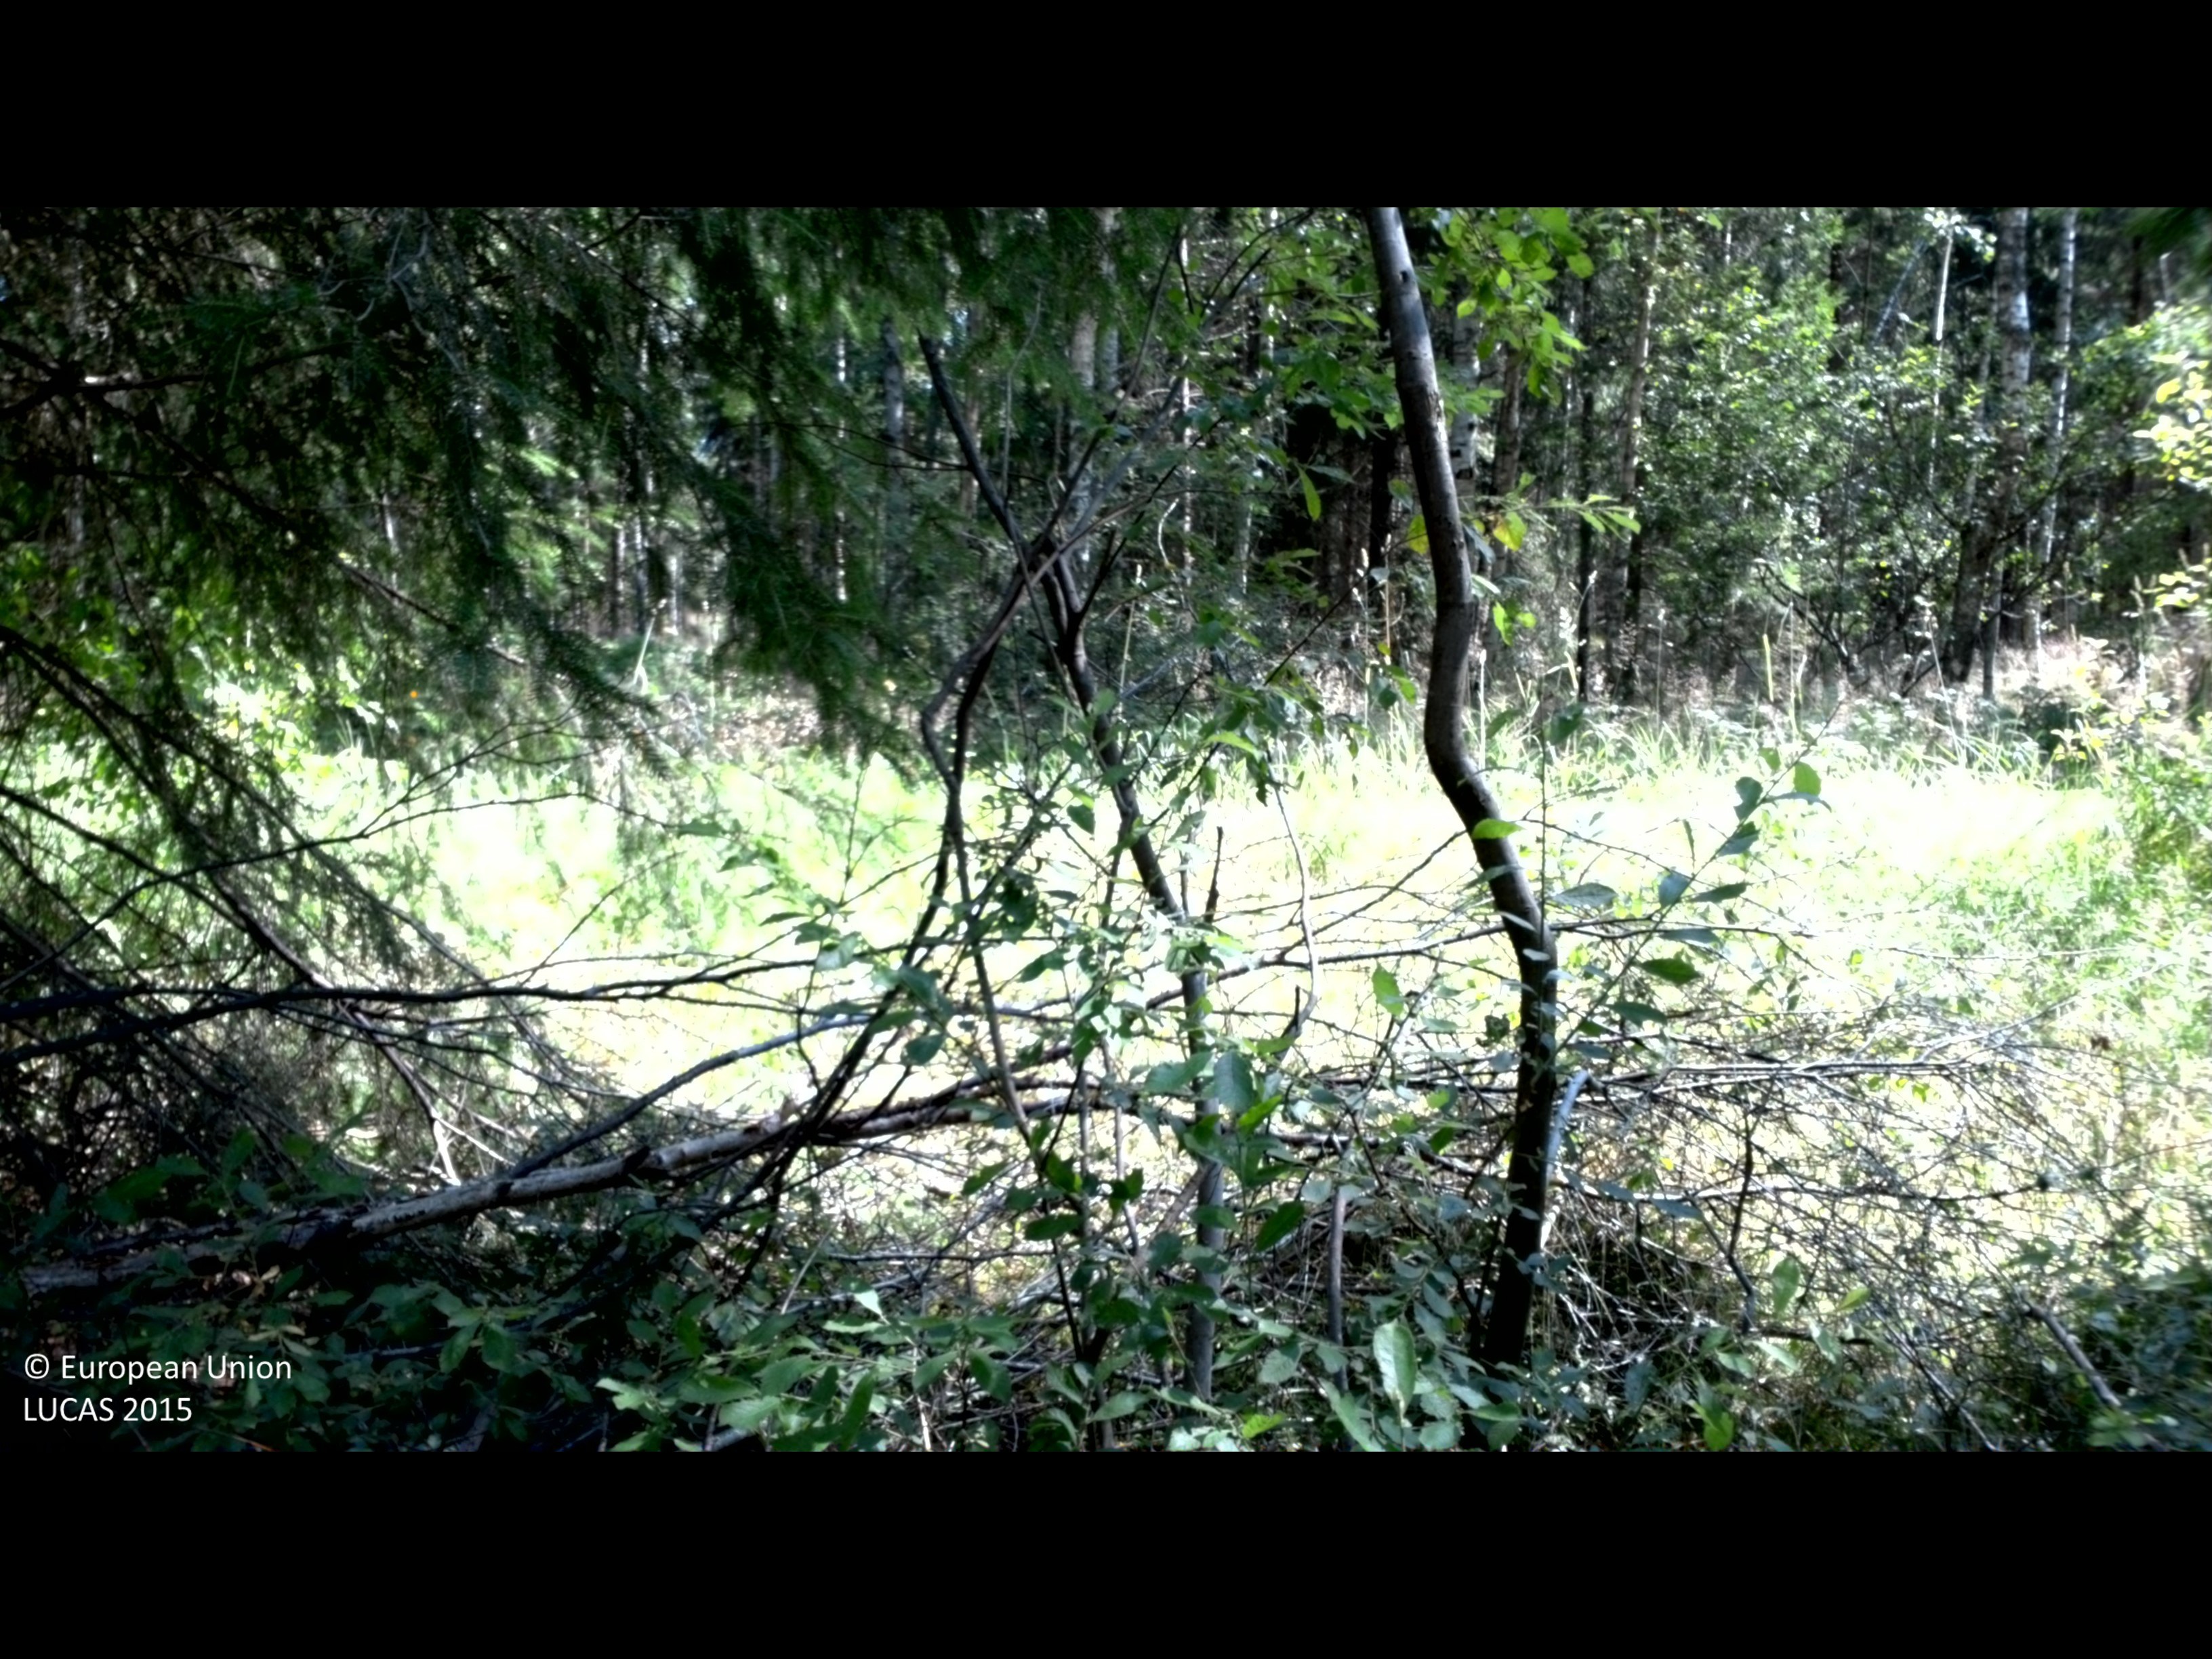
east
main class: Woodland
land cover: Spruce dominated mixed woodland
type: boreal forest
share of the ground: 50 - 75 %
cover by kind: coniferous forest trees 45 %, herbaceous plants 25 %, broadleaved forest trees 15 %, shrubs 15 %
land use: Forestry
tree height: > 5 m
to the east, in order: Spruce dominated mixed woodland; Grass margins; Paved roads, cycling and walking lanes; Grass margins; Spruce dominated mixed woodland; Ditches and canals; Spruce dominated mixed woodland; Broadleaved woodland; Pine dominated mixed woodland; Broadleaved woodland
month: August
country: SE
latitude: 56.4052
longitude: 14.2593
